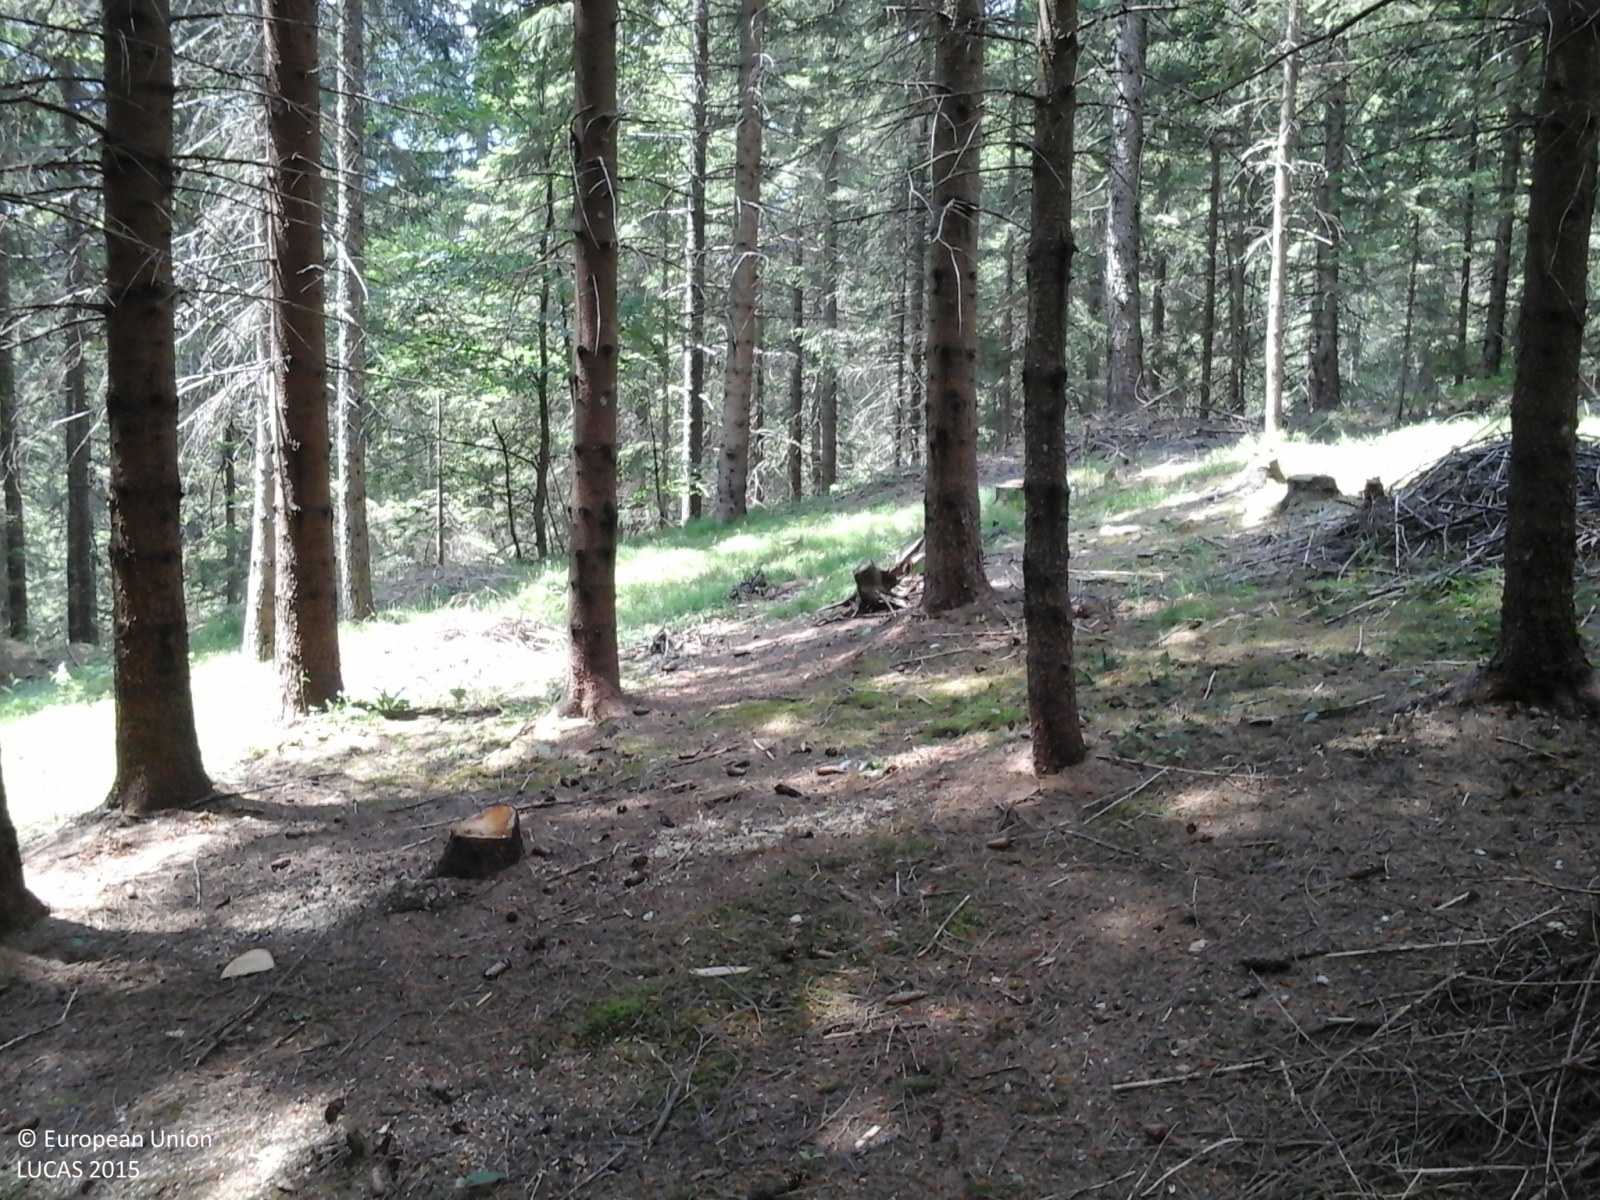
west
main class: Woodland
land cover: Spruce dominated coniferous woodland
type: alpine coniferous forest
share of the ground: > 75 %
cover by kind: coniferous forest trees 95 %, herbaceous plants 5 %
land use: Forestry
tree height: > 5 m
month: June
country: IT
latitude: 46.5701
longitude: 12.6720
